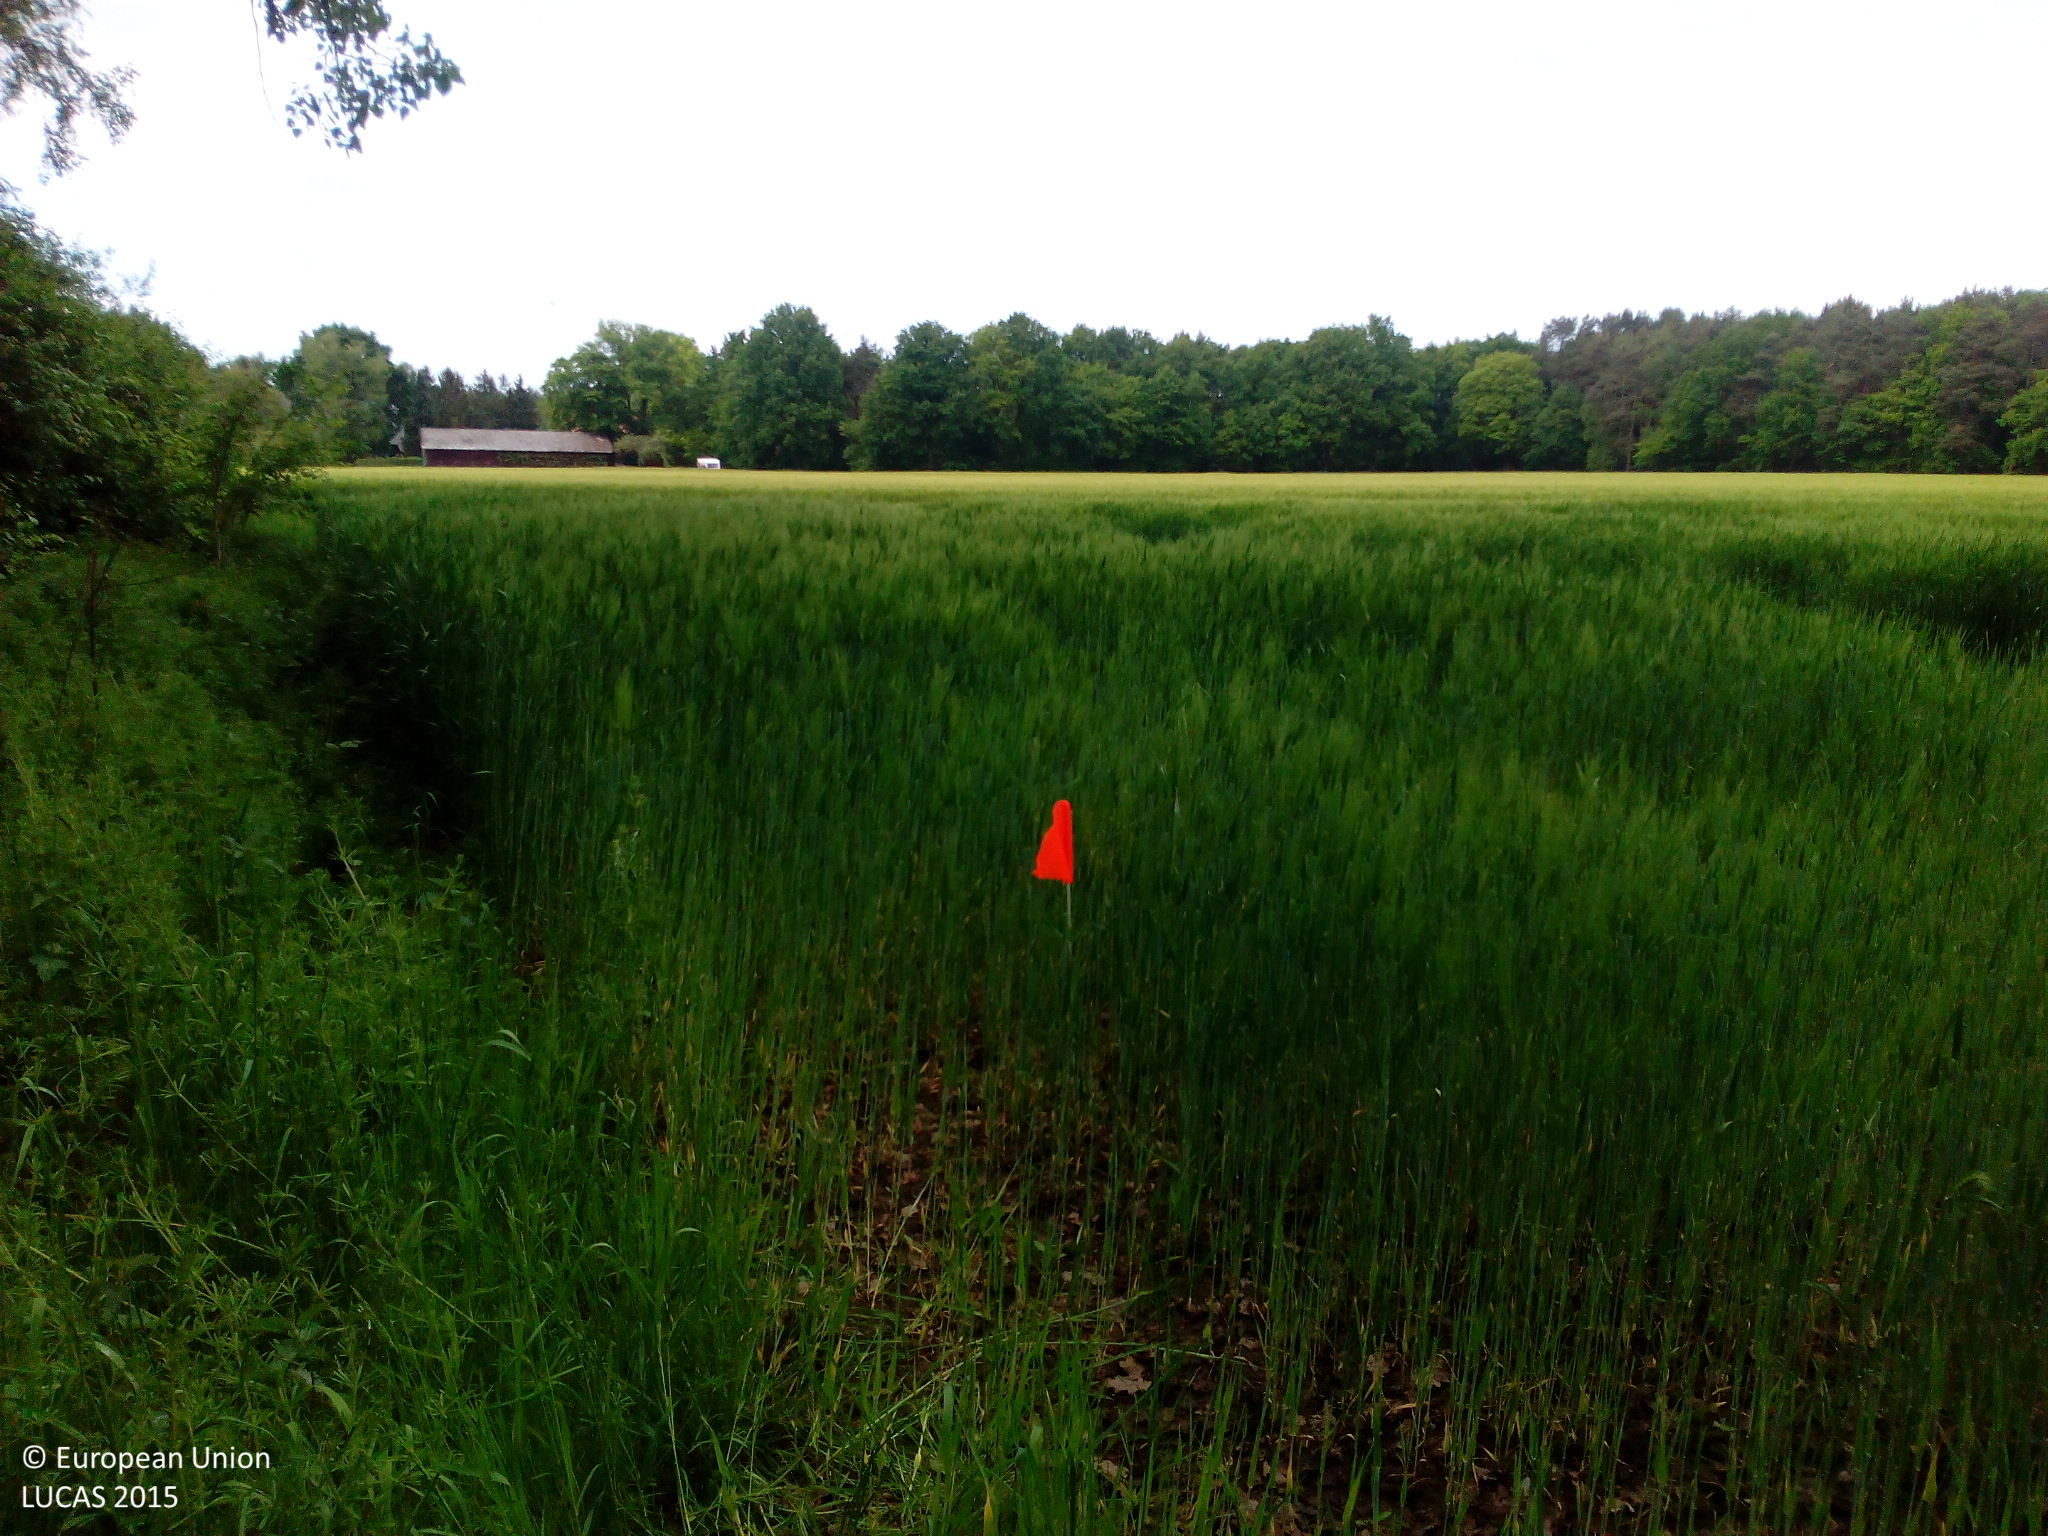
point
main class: Cropland
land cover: Barley
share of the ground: > 75 %
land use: Agriculture (excluding fallow land and kitchen gardens)
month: May
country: DE
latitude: 52.0191
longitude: 8.0040
